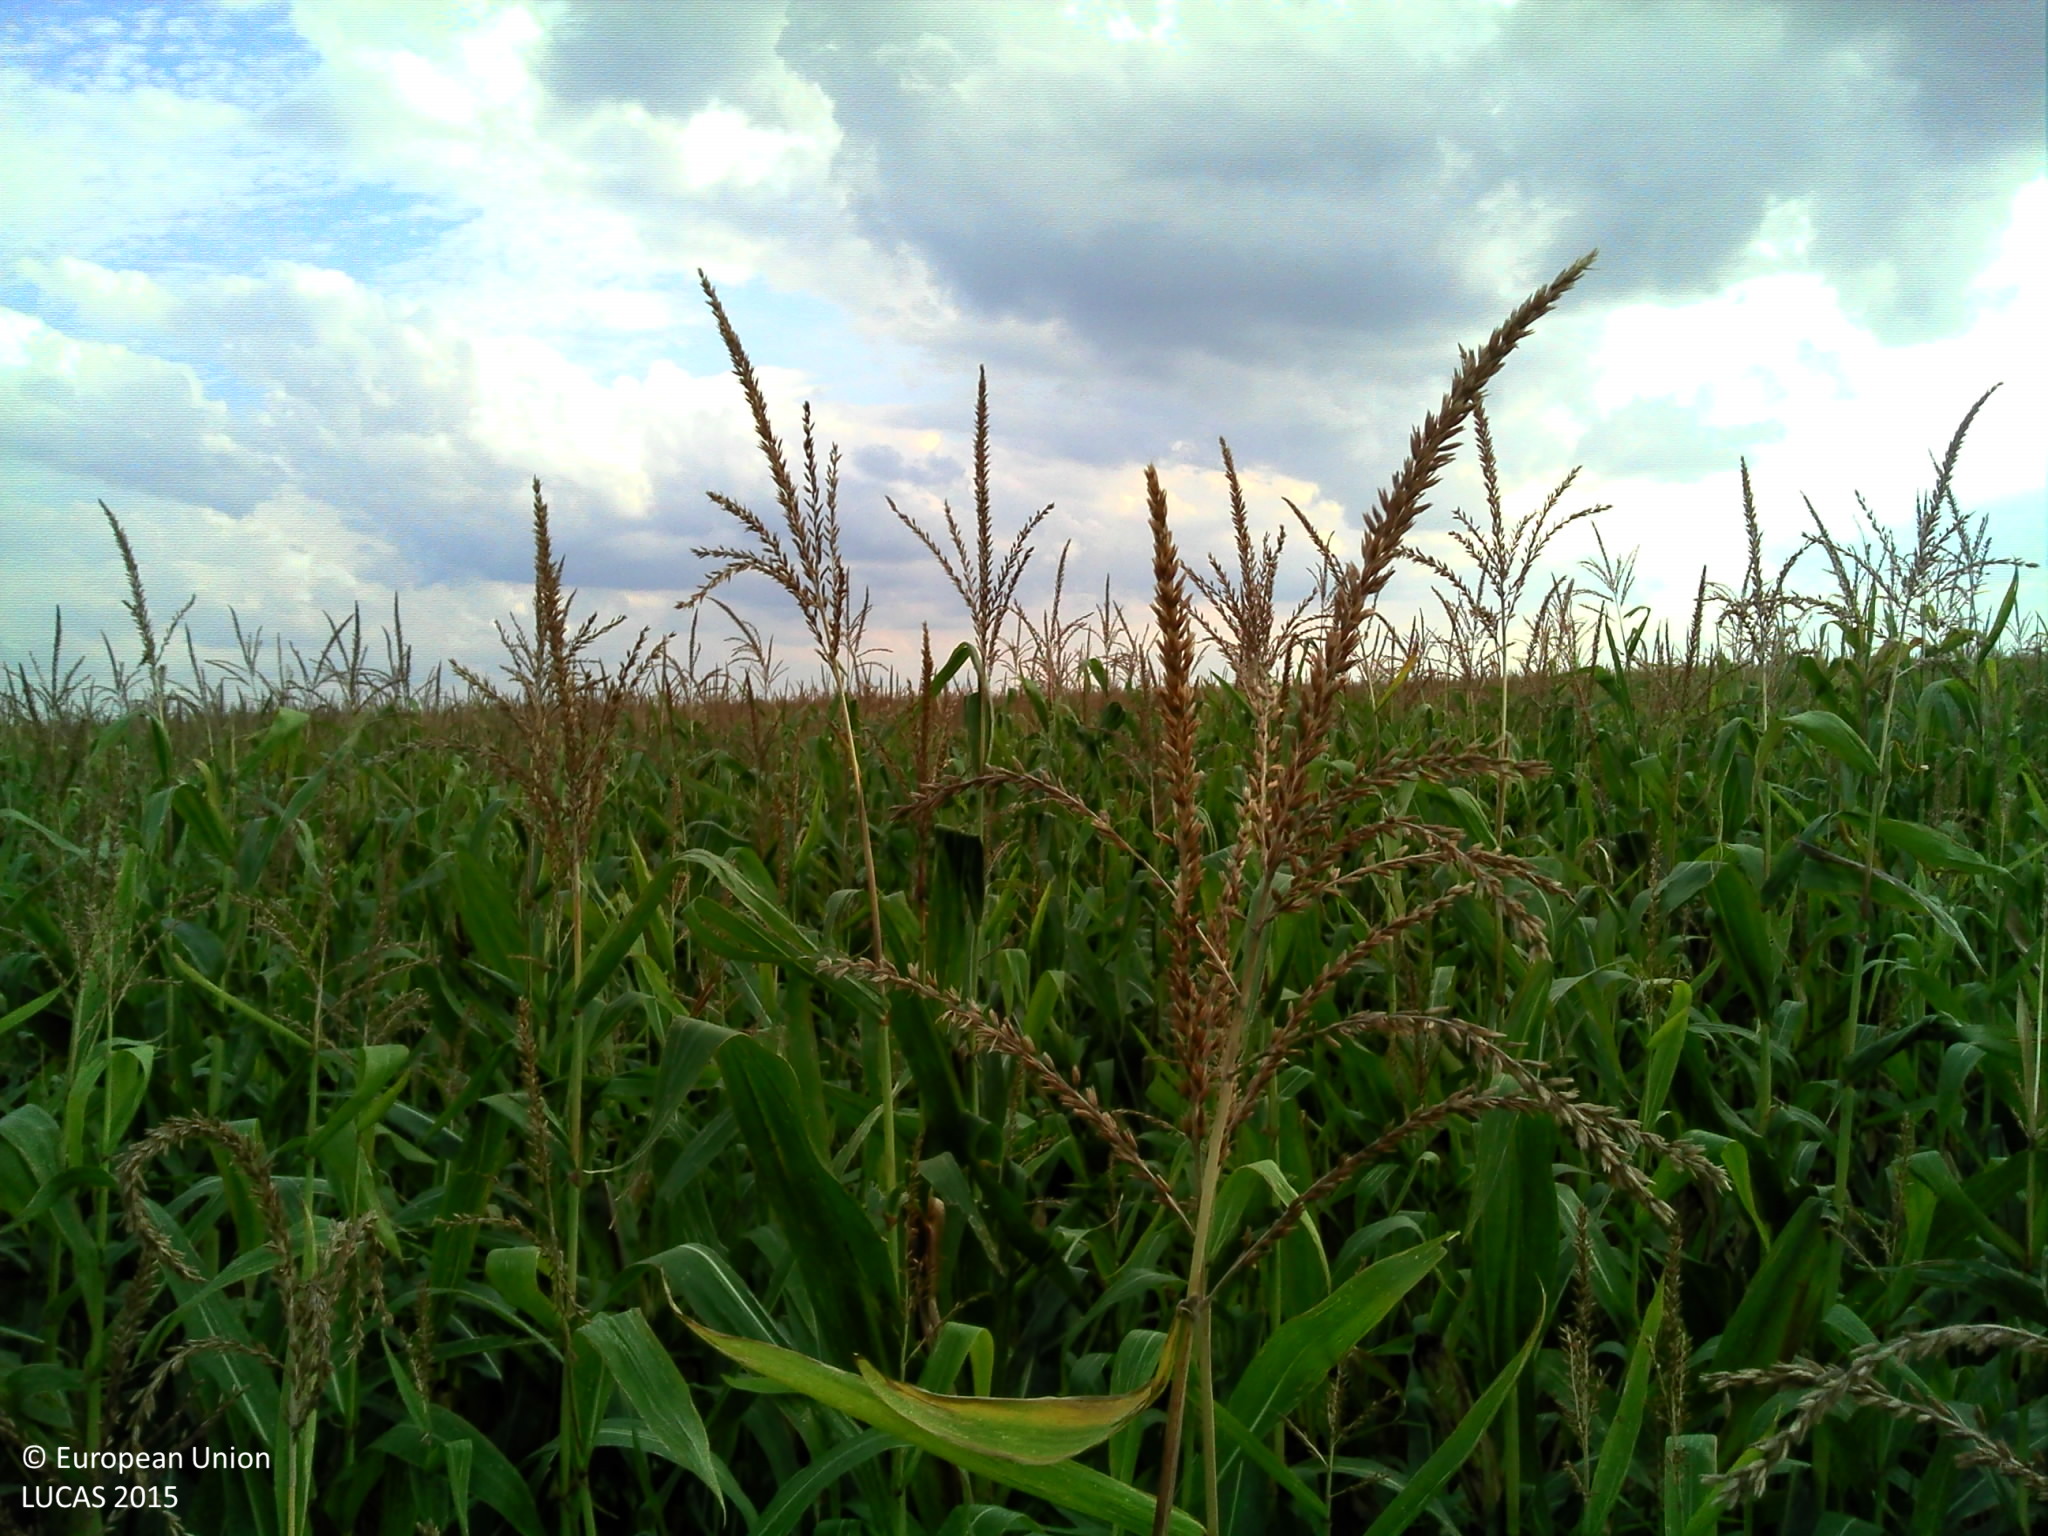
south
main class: Cropland
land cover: Maize
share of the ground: > 75 %
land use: Agriculture (excluding fallow land and kitchen gardens)
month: September
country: FR
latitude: 46.7251
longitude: 0.9175
